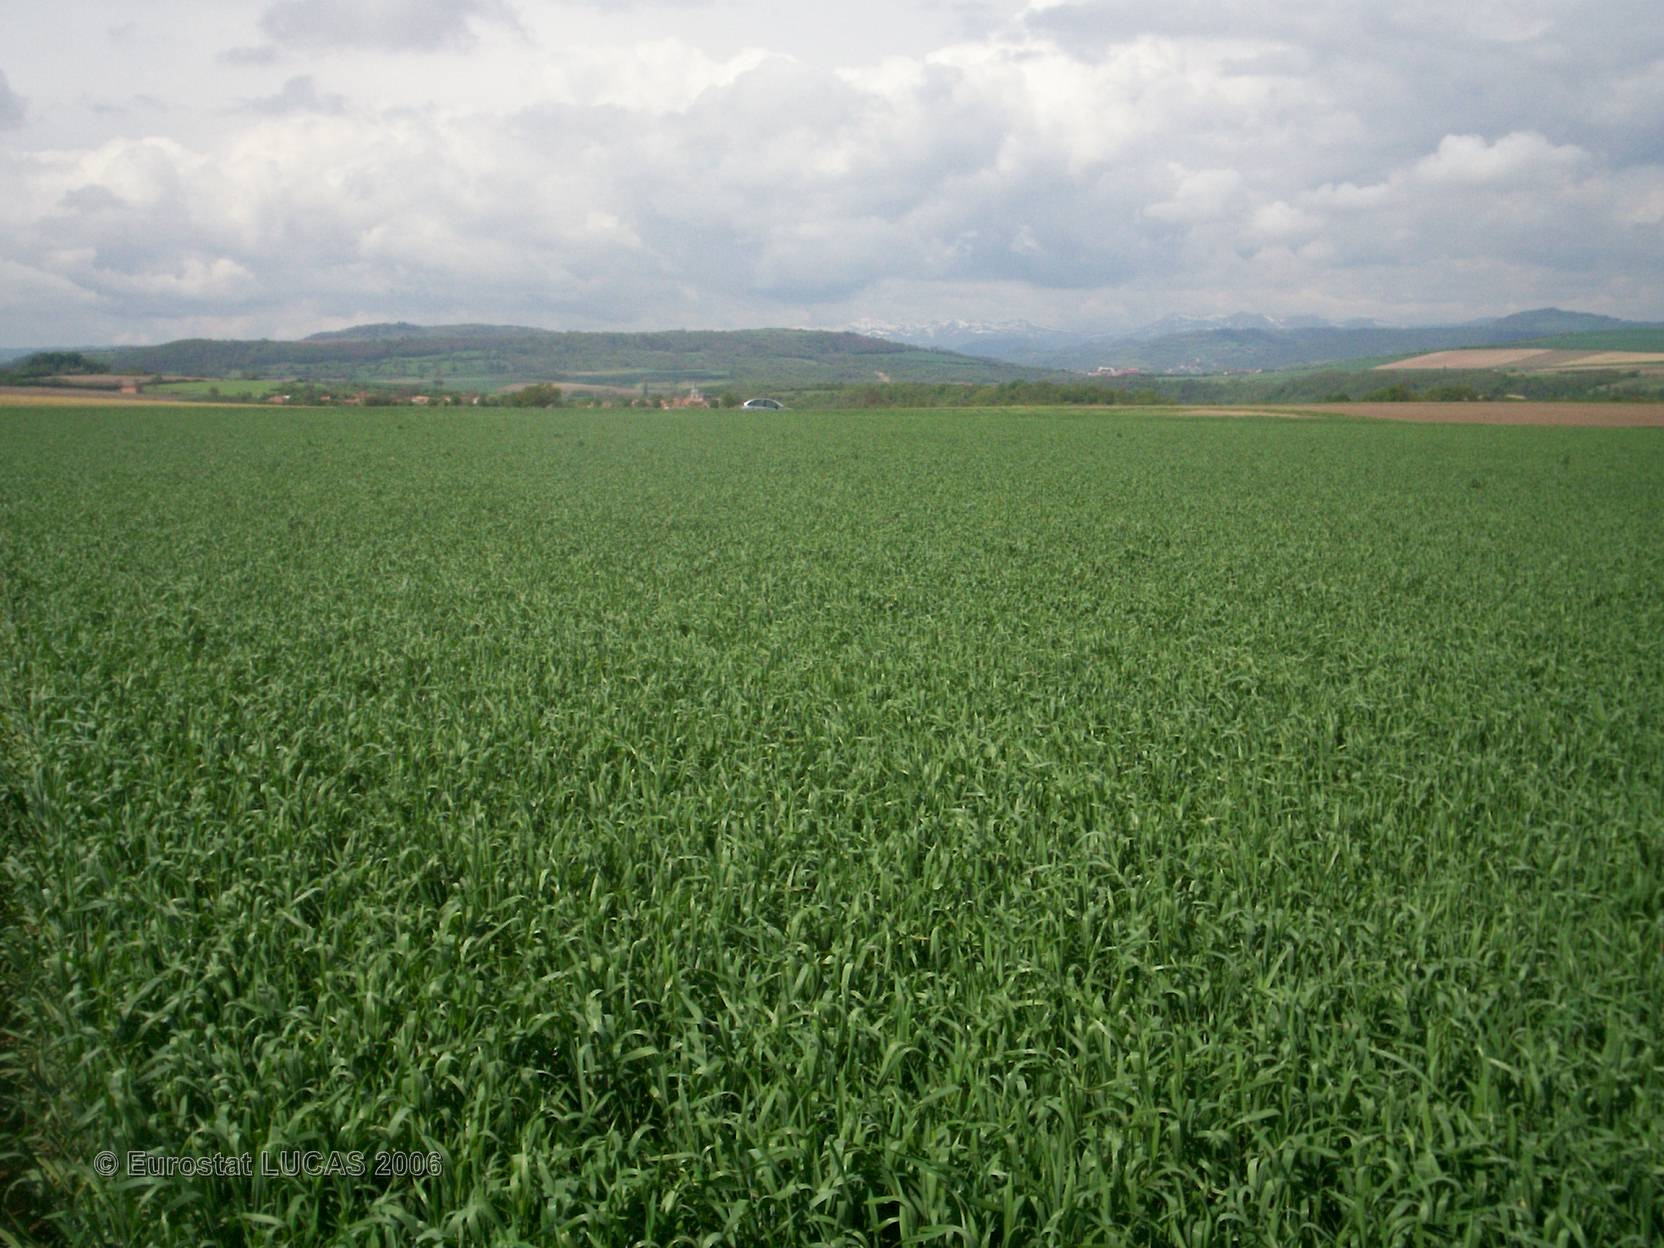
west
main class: Cropland
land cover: Common wheat
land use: Agriculture (excluding fallow land and kitchen gardens)
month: May
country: FR
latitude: 45.5921
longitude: 3.1940
